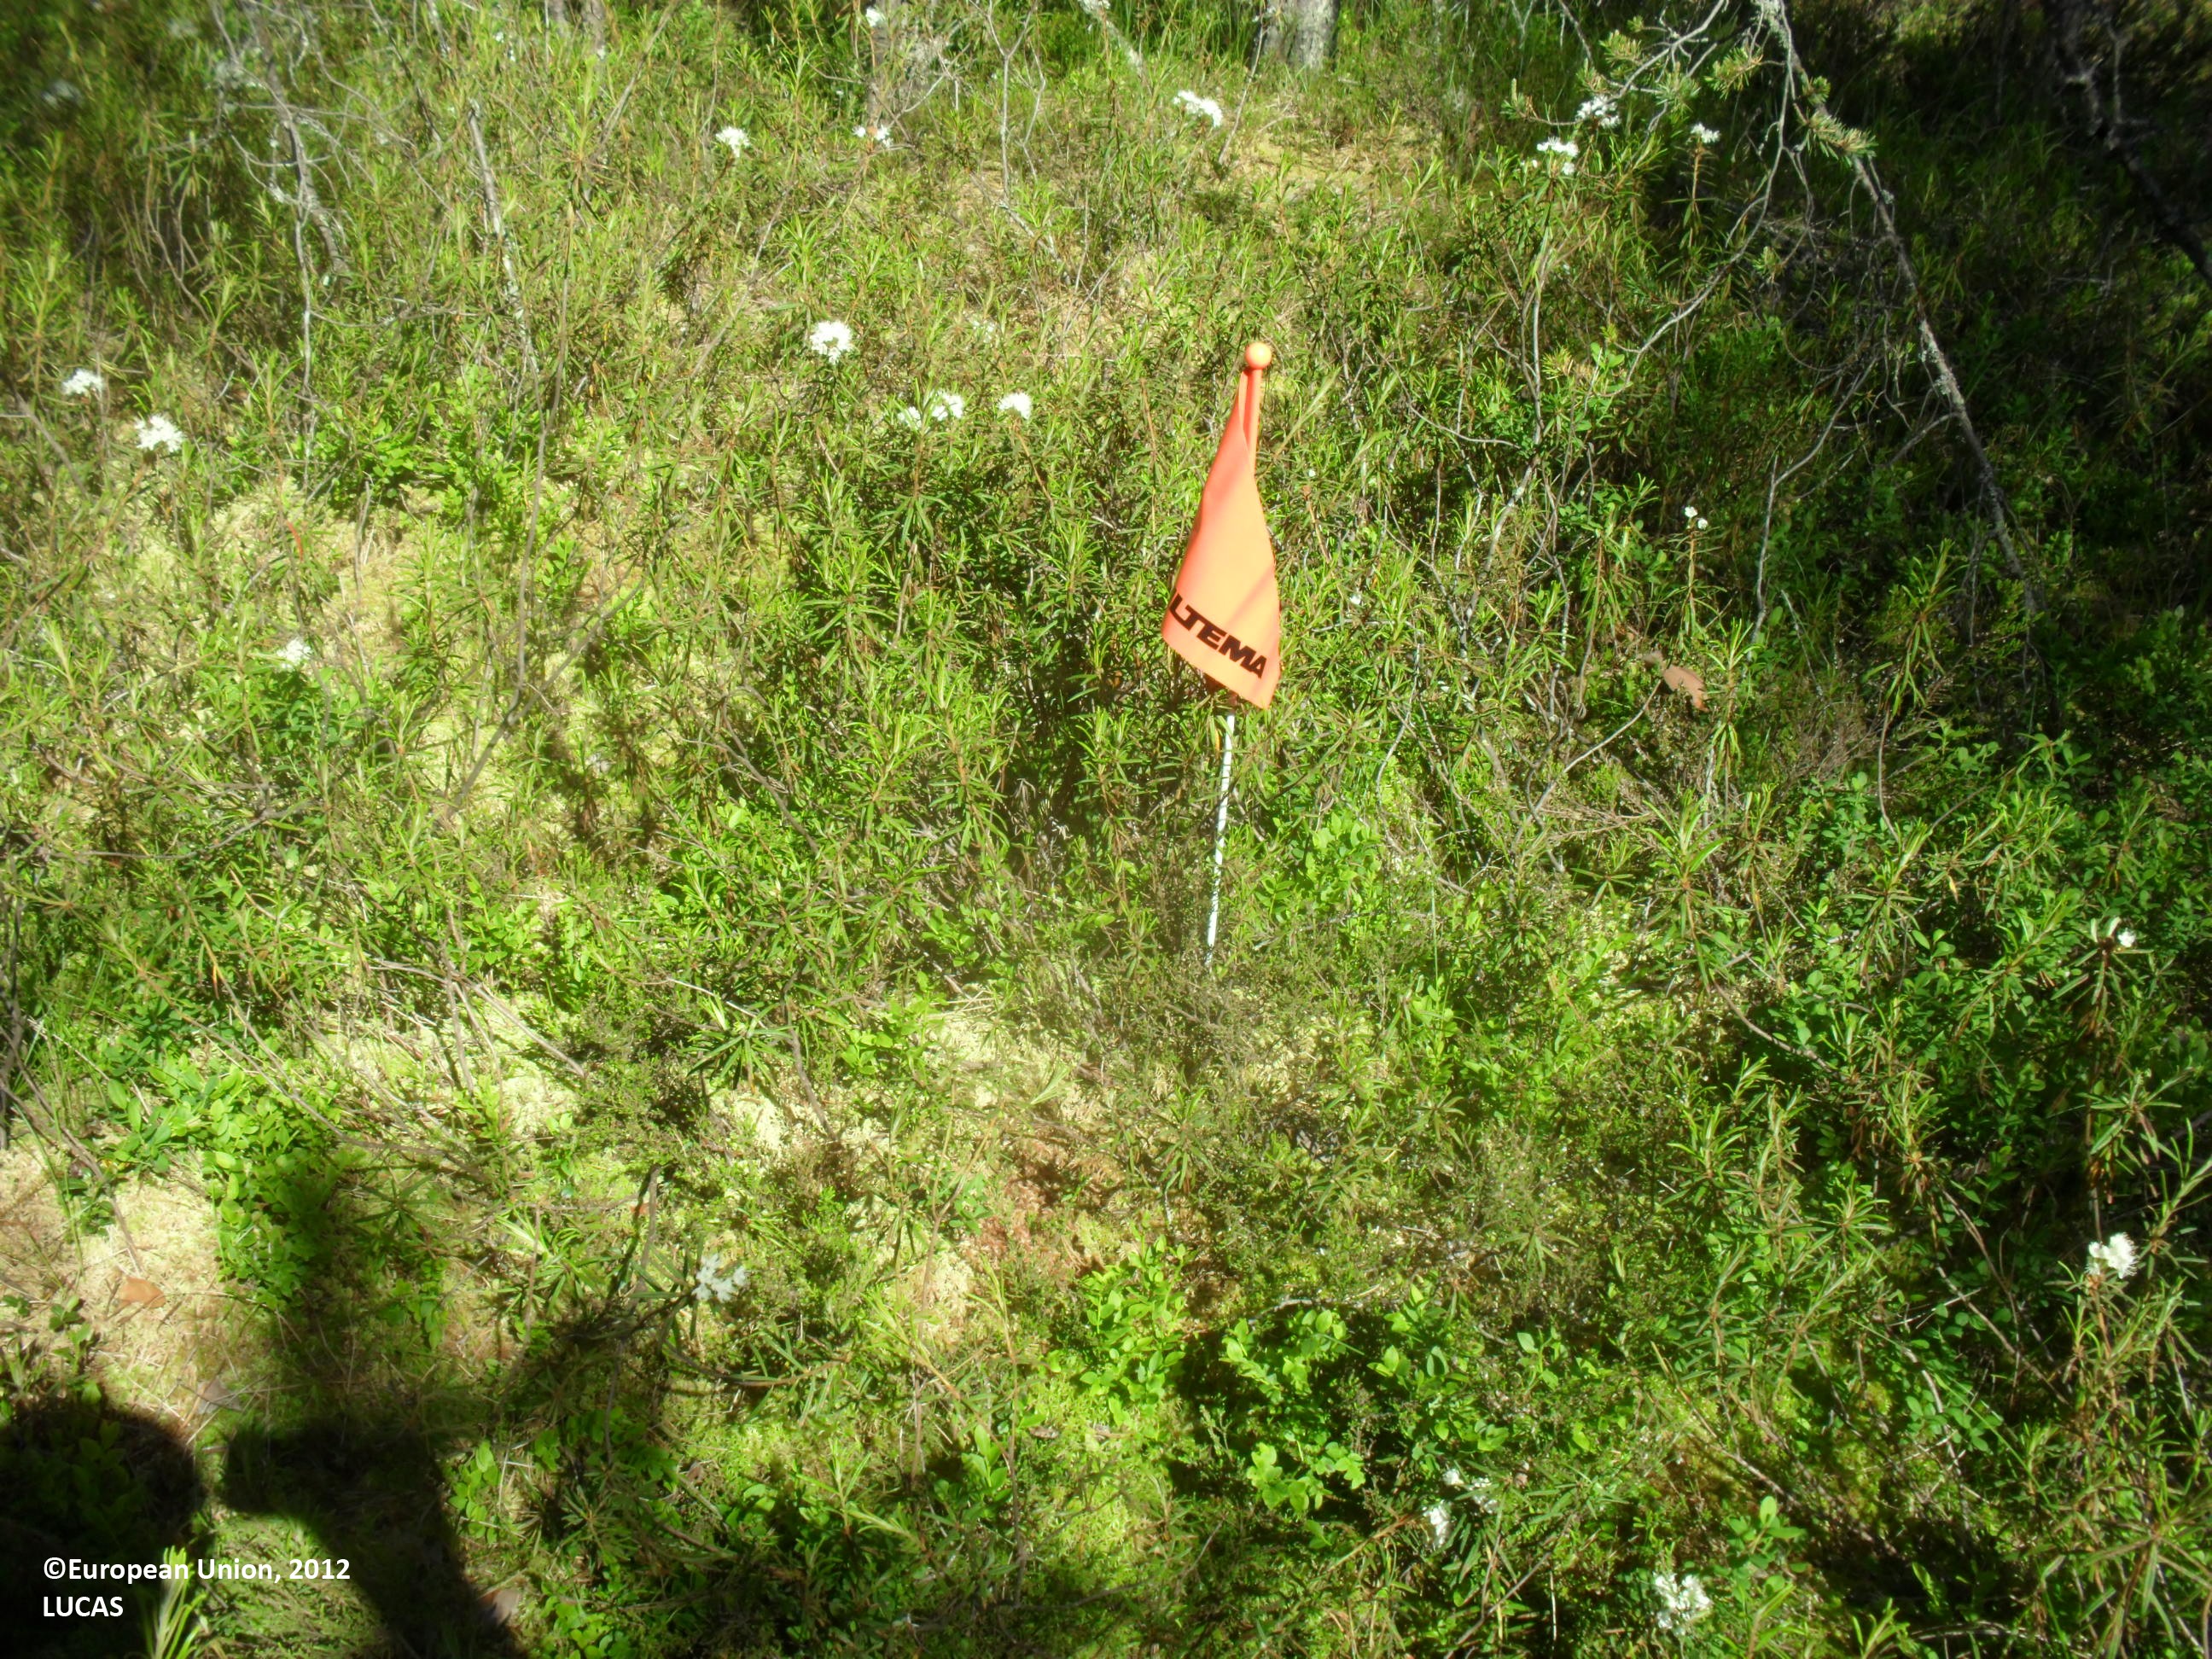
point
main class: Woodland
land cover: Pine dominated mixed woodland
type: boreal forest
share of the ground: 25 - 50 %
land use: Forestry
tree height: > 5 m
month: June
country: FI
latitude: 63.1871
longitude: 23.1543
